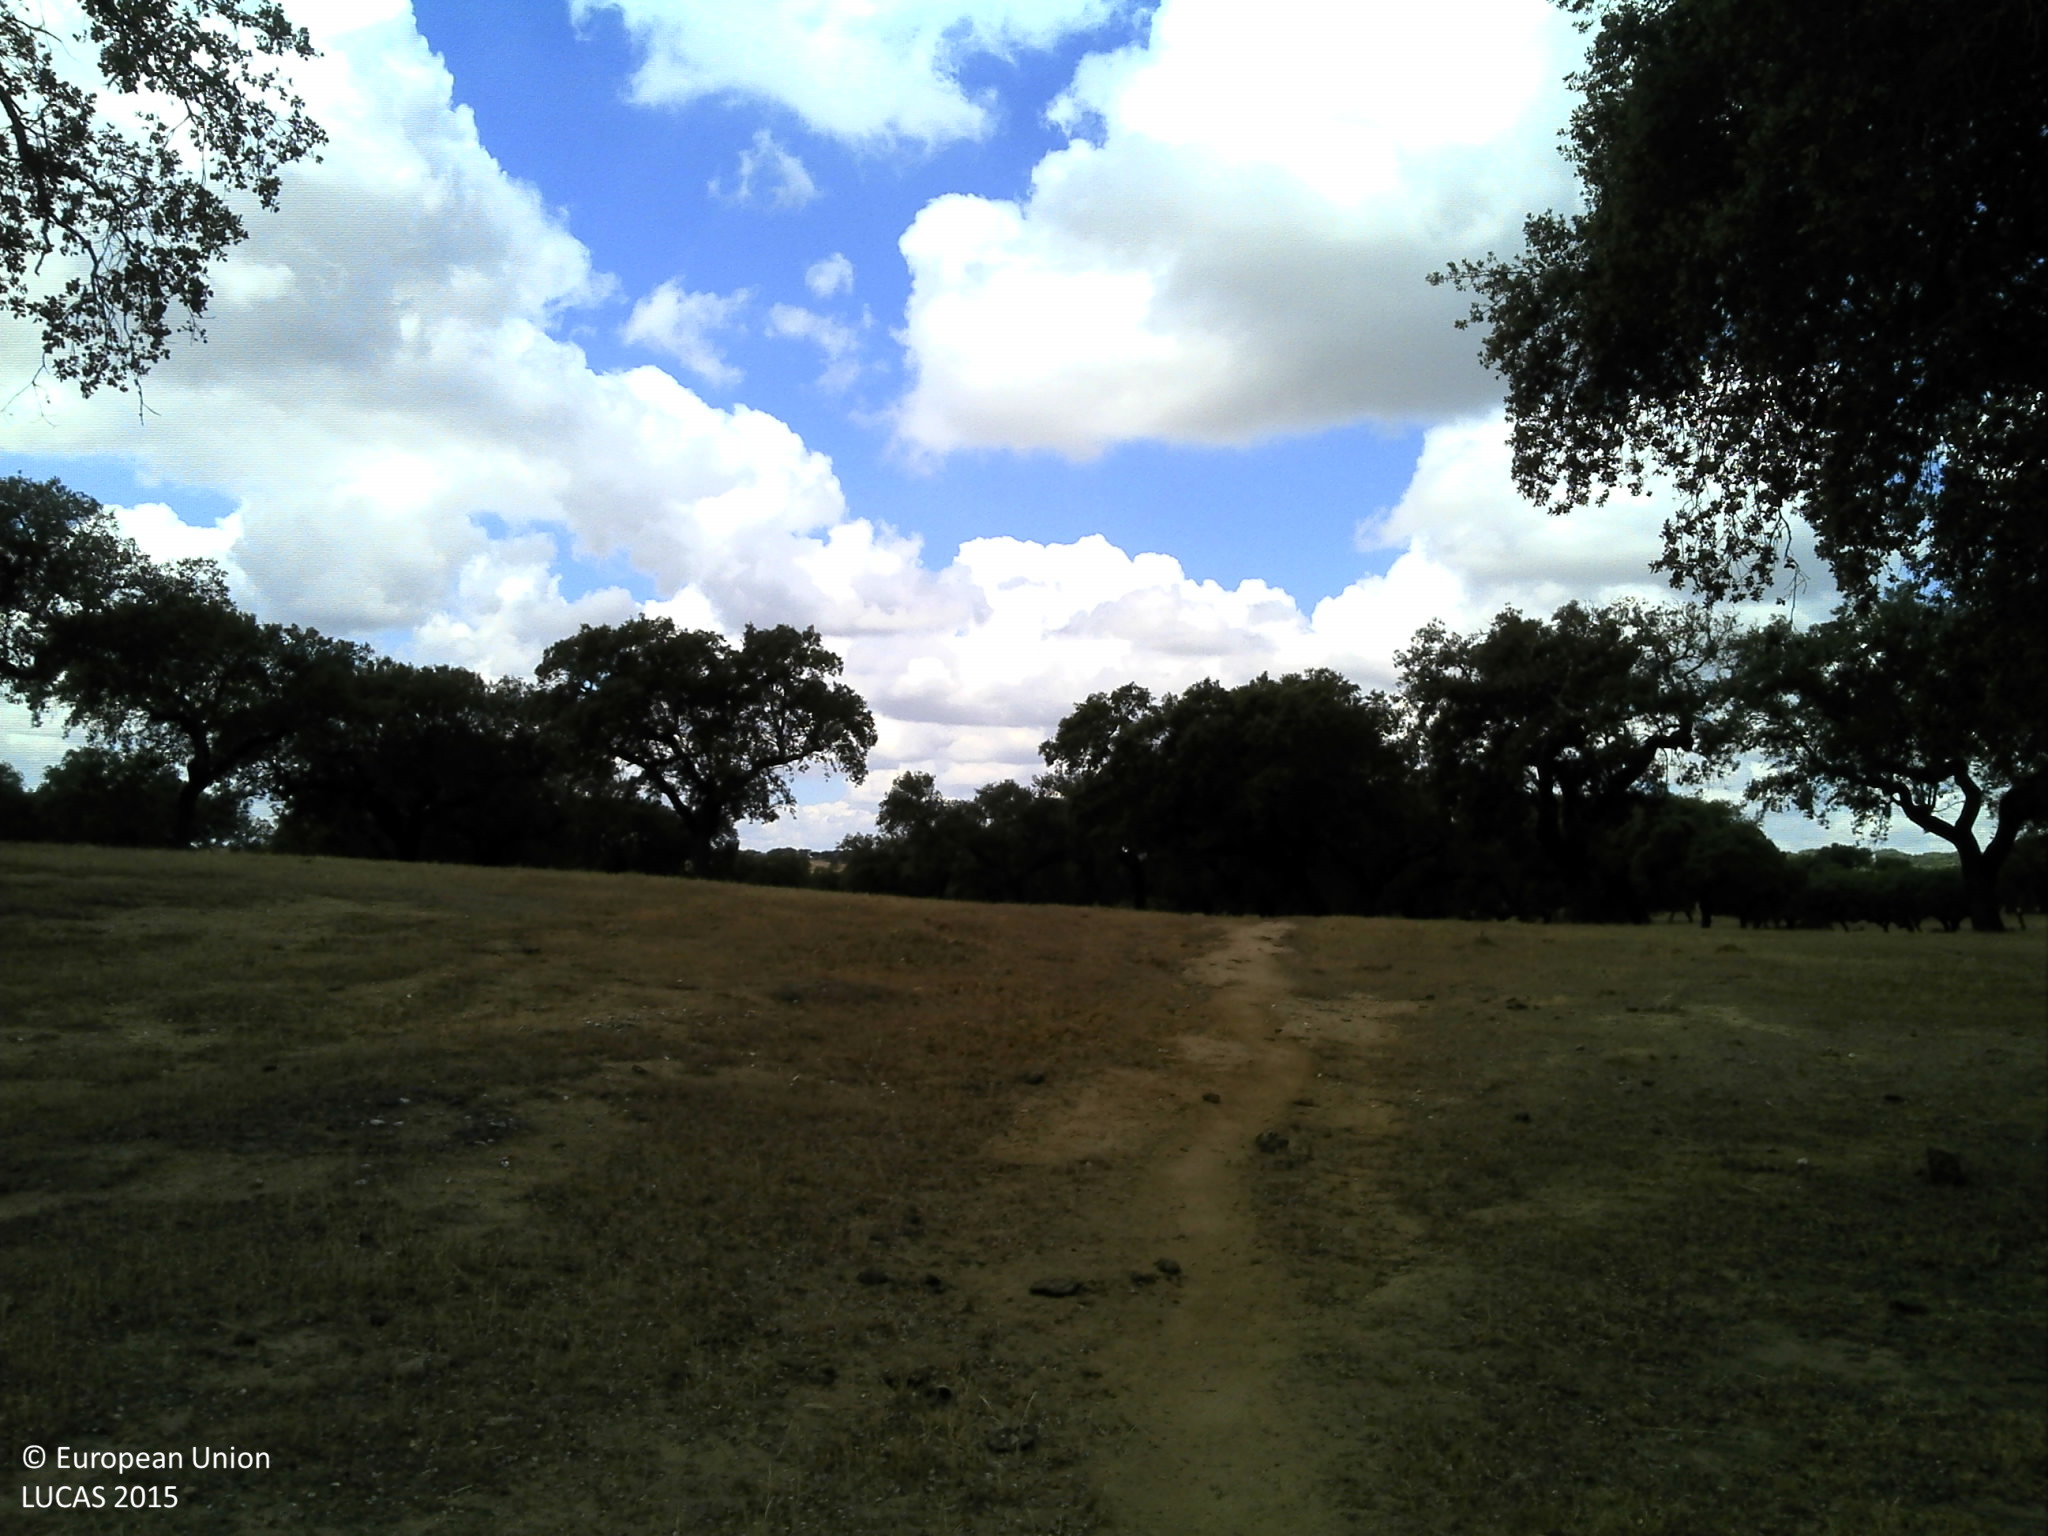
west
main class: Woodland
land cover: Broadleaved woodland
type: broadleaved evergreen forest
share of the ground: 10 - 25 %
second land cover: Grassland without tree/shrub cover
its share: 10 - 25 %
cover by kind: unconsolidated bare surface 70 %, broadleaved forest trees 15 %, herbaceous plants 15 %
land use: Forestry
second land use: Agriculture (excluding fallow land and kitchen gardens)
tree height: > 5 m
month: June
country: PT
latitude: 38.5199
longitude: -8.0609
